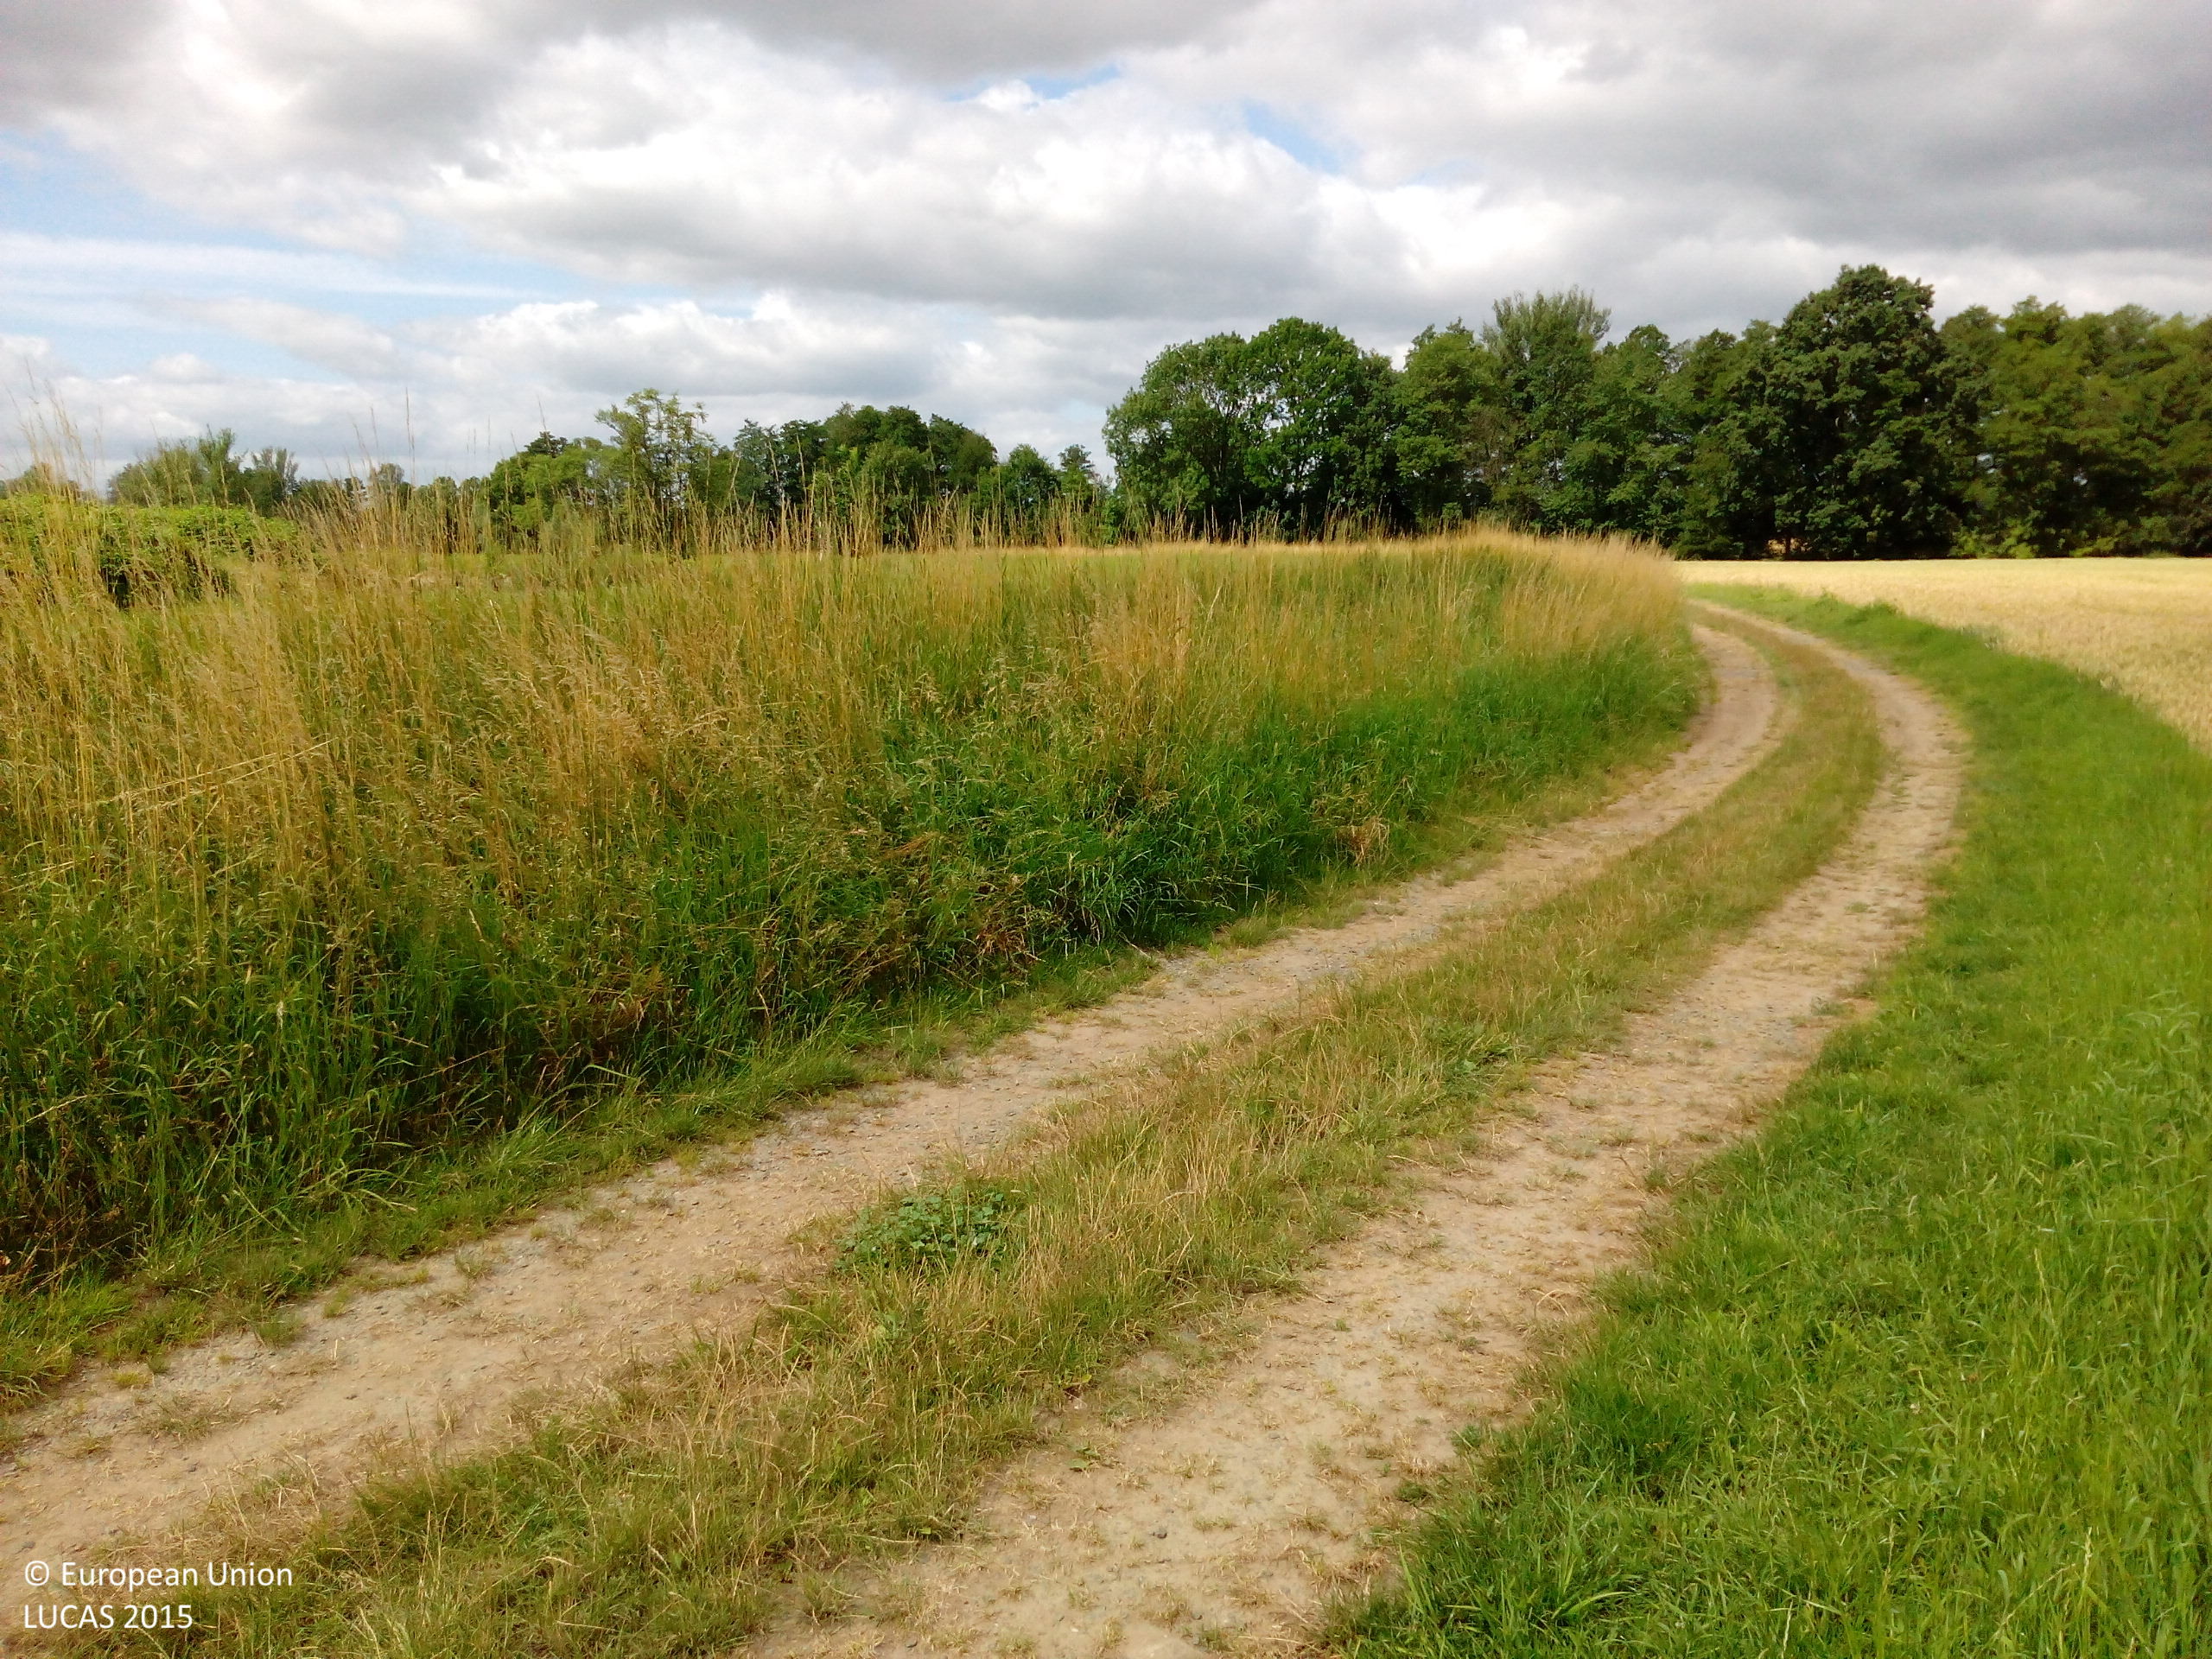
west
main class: Cropland
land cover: Common wheat
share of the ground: > 75 %
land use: Agriculture (excluding fallow land and kitchen gardens)
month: July
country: DE
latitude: 51.2442
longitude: 15.0312
